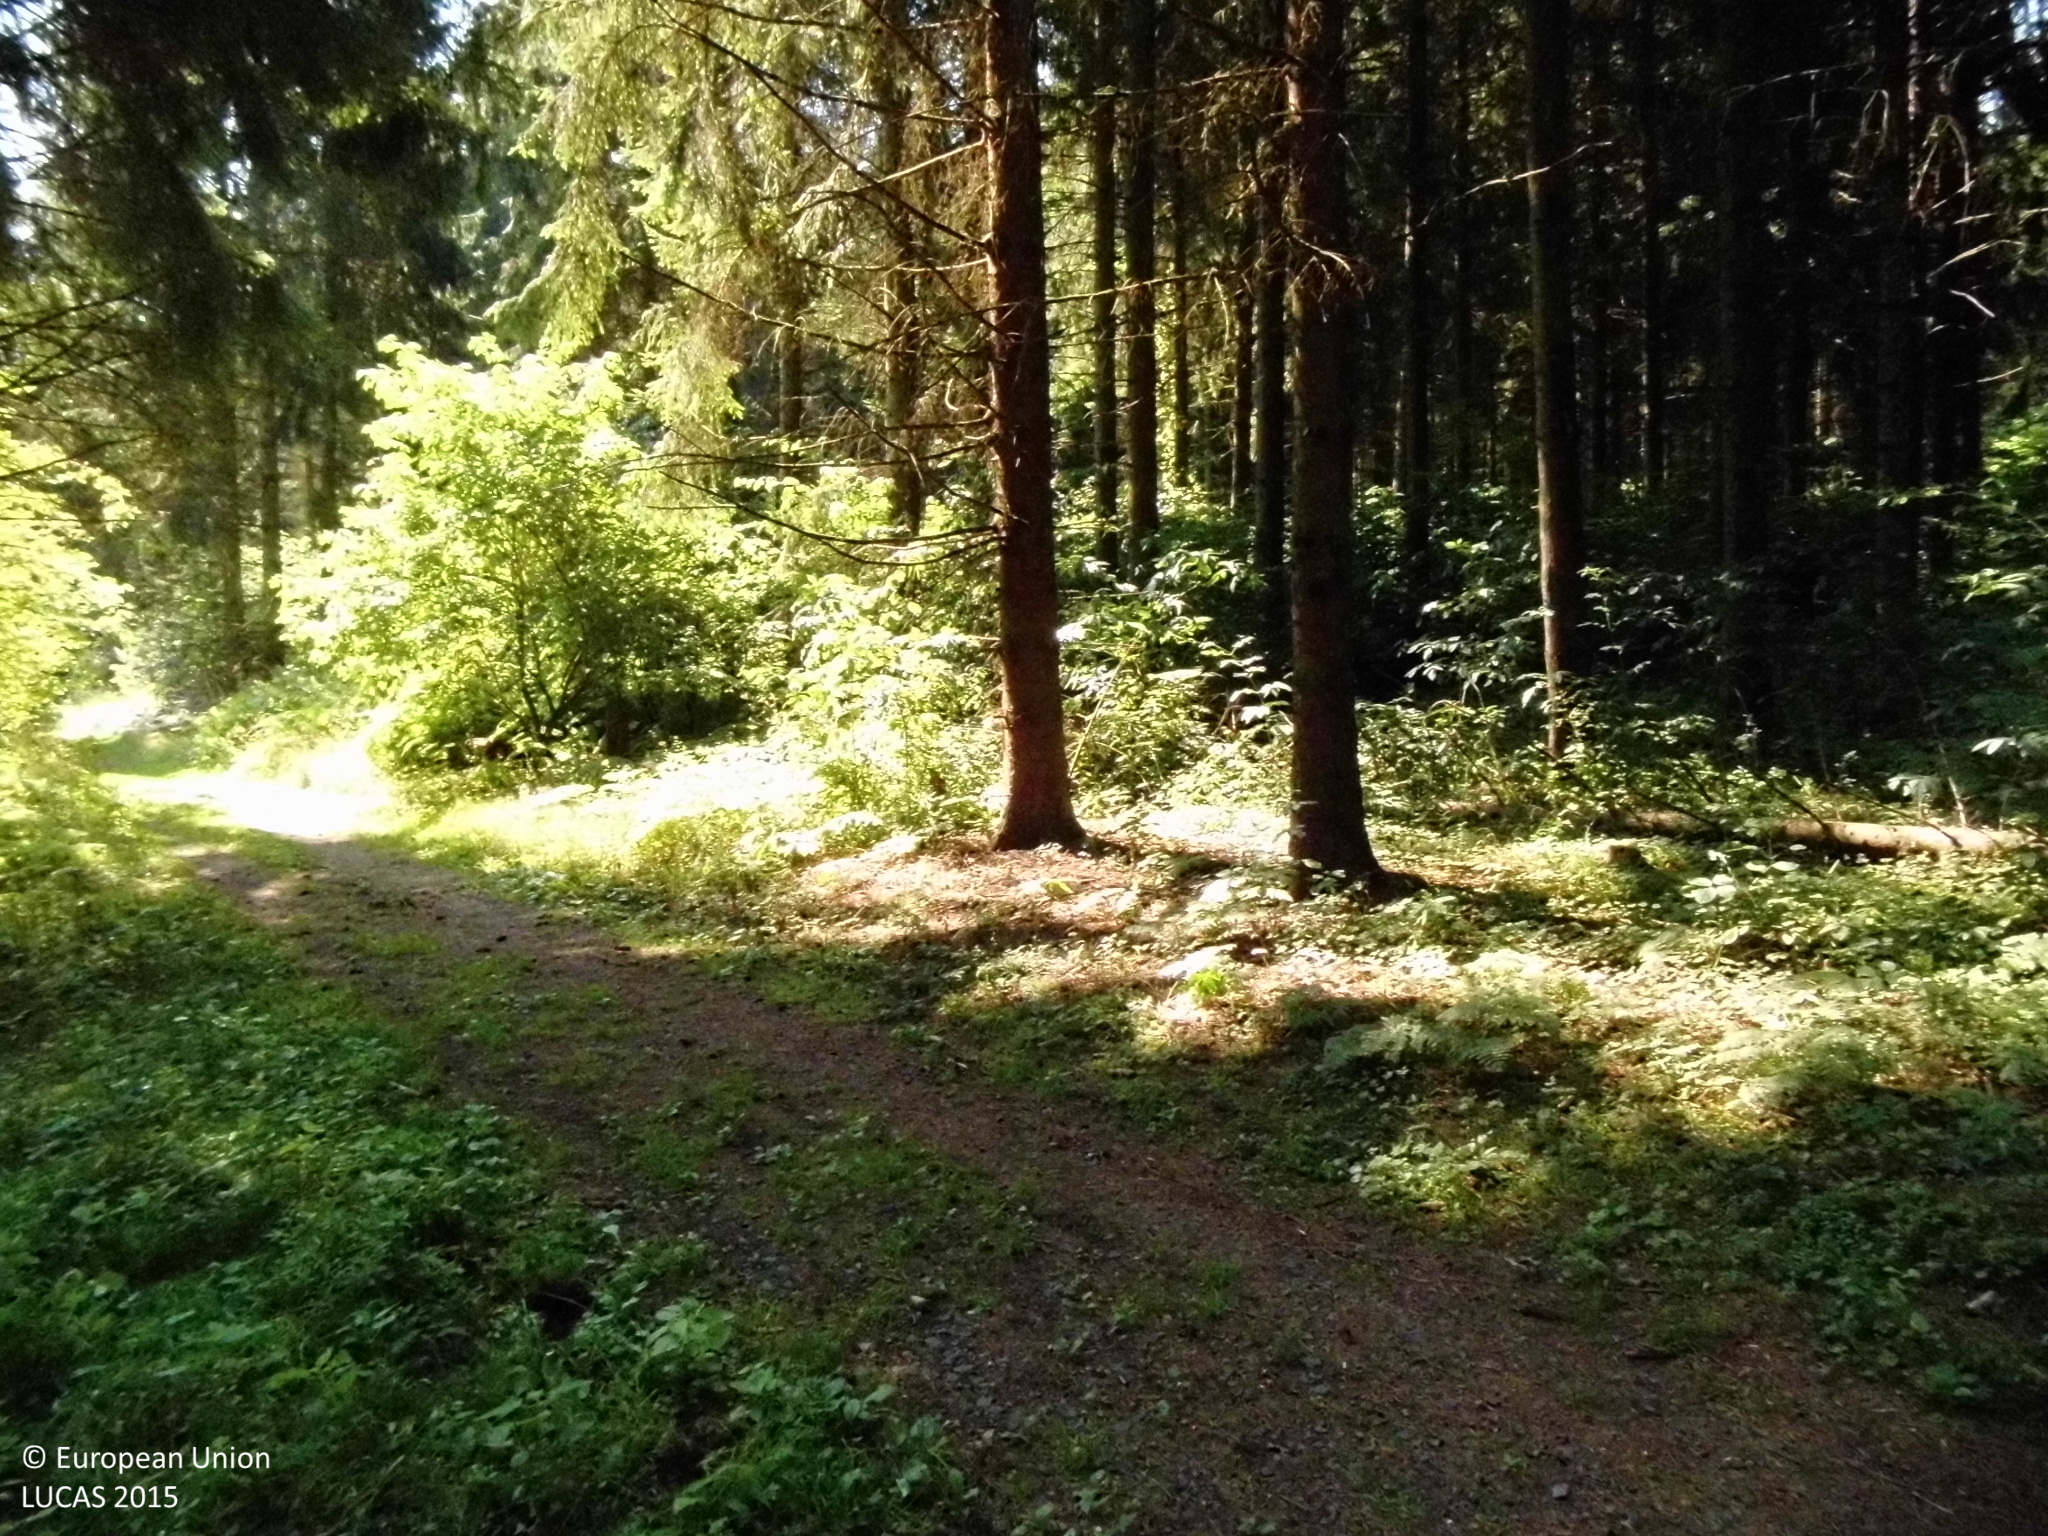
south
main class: Woodland
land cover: Spruce dominated coniferous woodland
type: hemiboreal forest and nemoral coniferous forest and mixed broadleaved-coniferous forest
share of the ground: > 75 %
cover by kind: coniferous forest trees 75 %, herbaceous plants 10 %, broadleaved forest trees 5 %, shrubs 5 %, unconsolidated bare surface 5 %
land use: Forestry
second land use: Amenities, museums, leisure
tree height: > 5 m
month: August
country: DE
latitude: 50.5626
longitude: 8.0099
